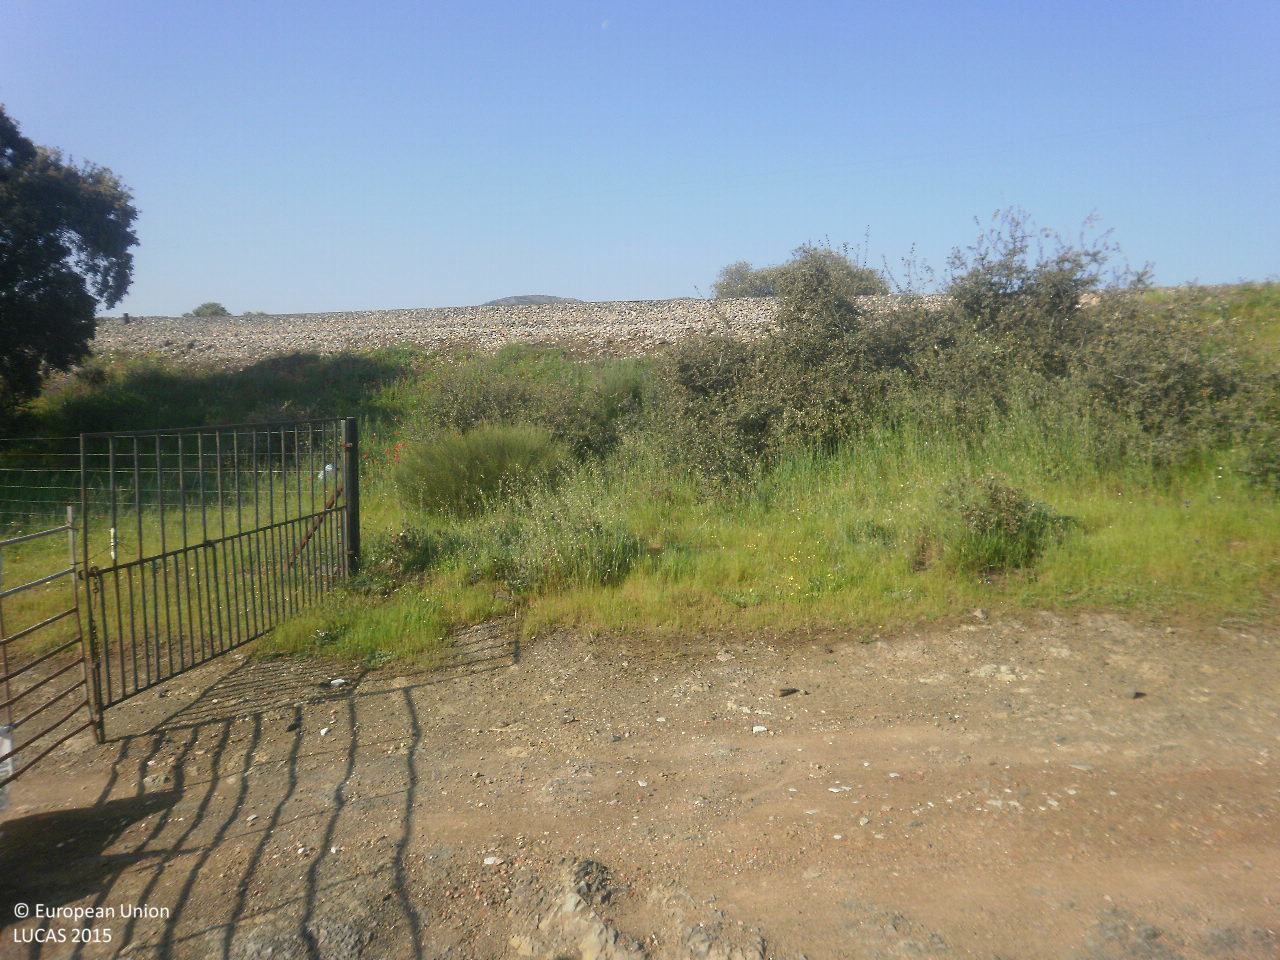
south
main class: Grassland
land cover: Grassland with sparse tree/shrub cover
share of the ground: > 75 %
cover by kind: herbaceous plants 95 %, broadleaved forest trees 5 %
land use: Agriculture (excluding fallow land and kitchen gardens)
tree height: > 5 m
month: April
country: ES
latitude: 38.7287
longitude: -5.1834
